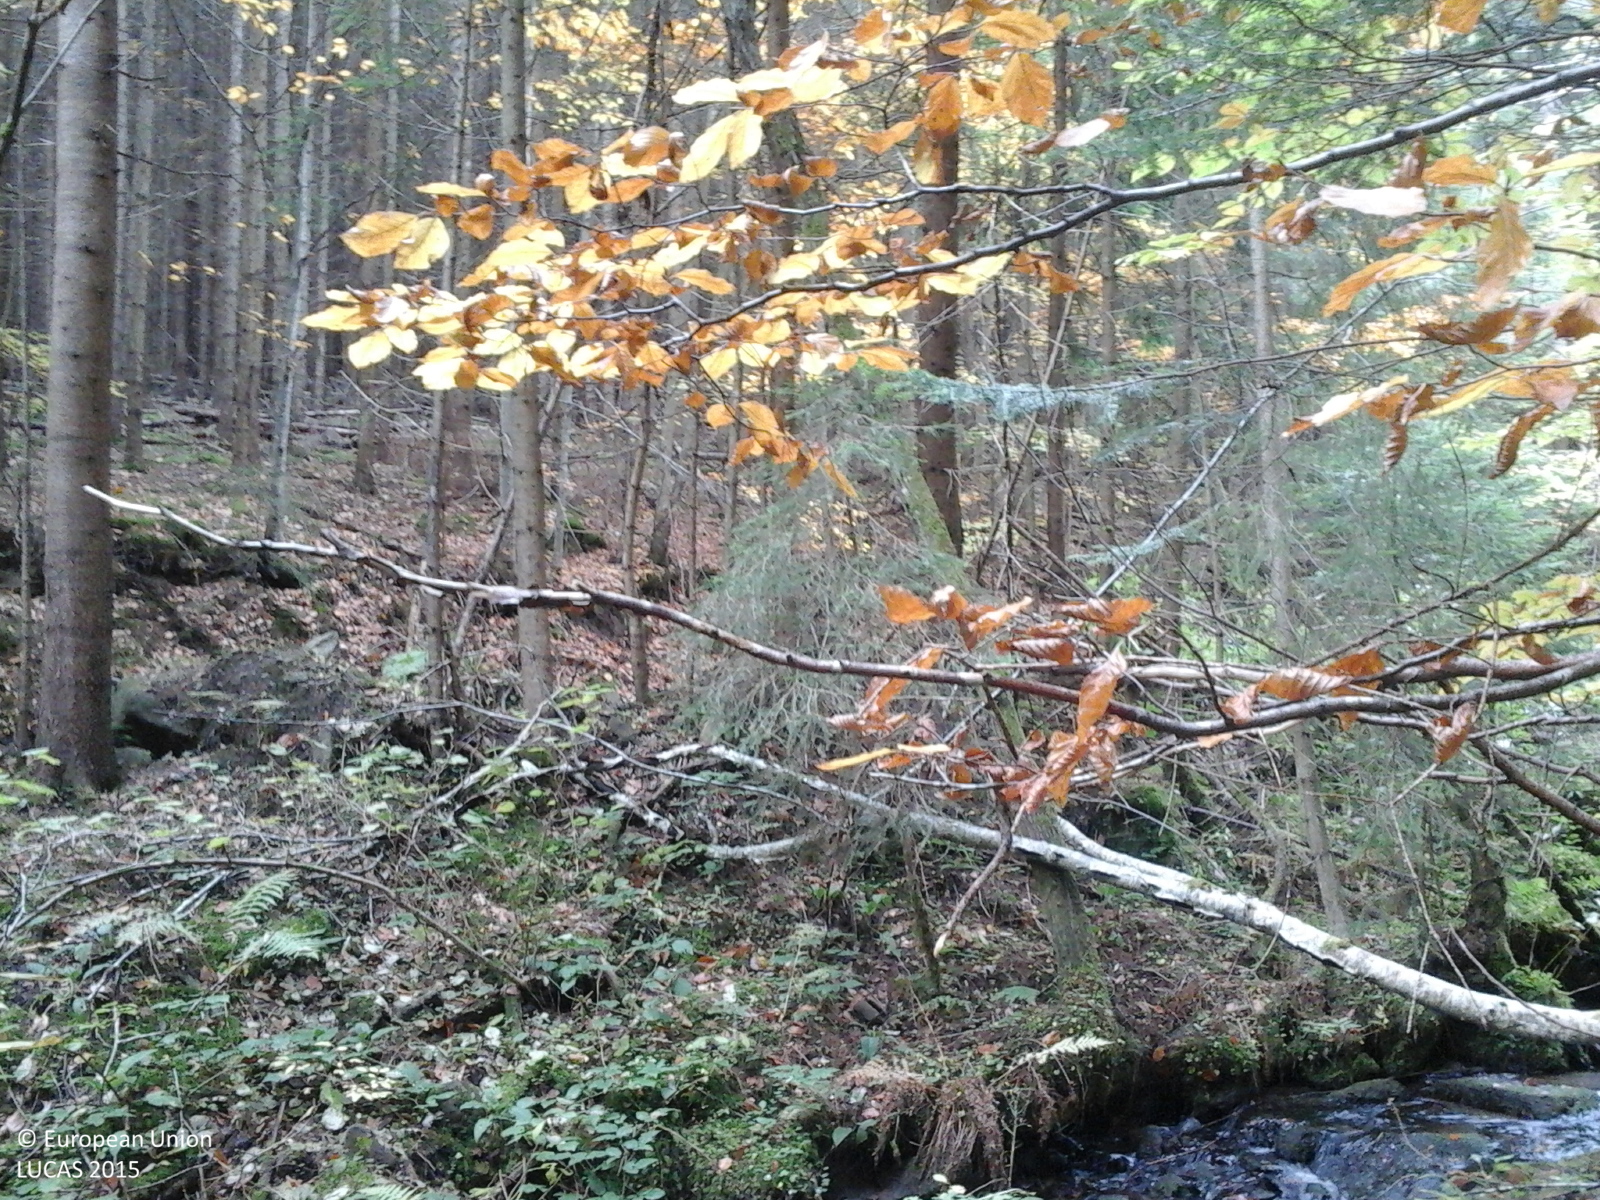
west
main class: Woodland
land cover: Spruce dominated mixed woodland
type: alpine coniferous forest
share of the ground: > 75 %
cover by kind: coniferous forest trees 60 %, broadleaved forest trees 40 %
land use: Forestry
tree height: > 5 m
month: October
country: RO
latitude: 46.5562
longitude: 25.4608
